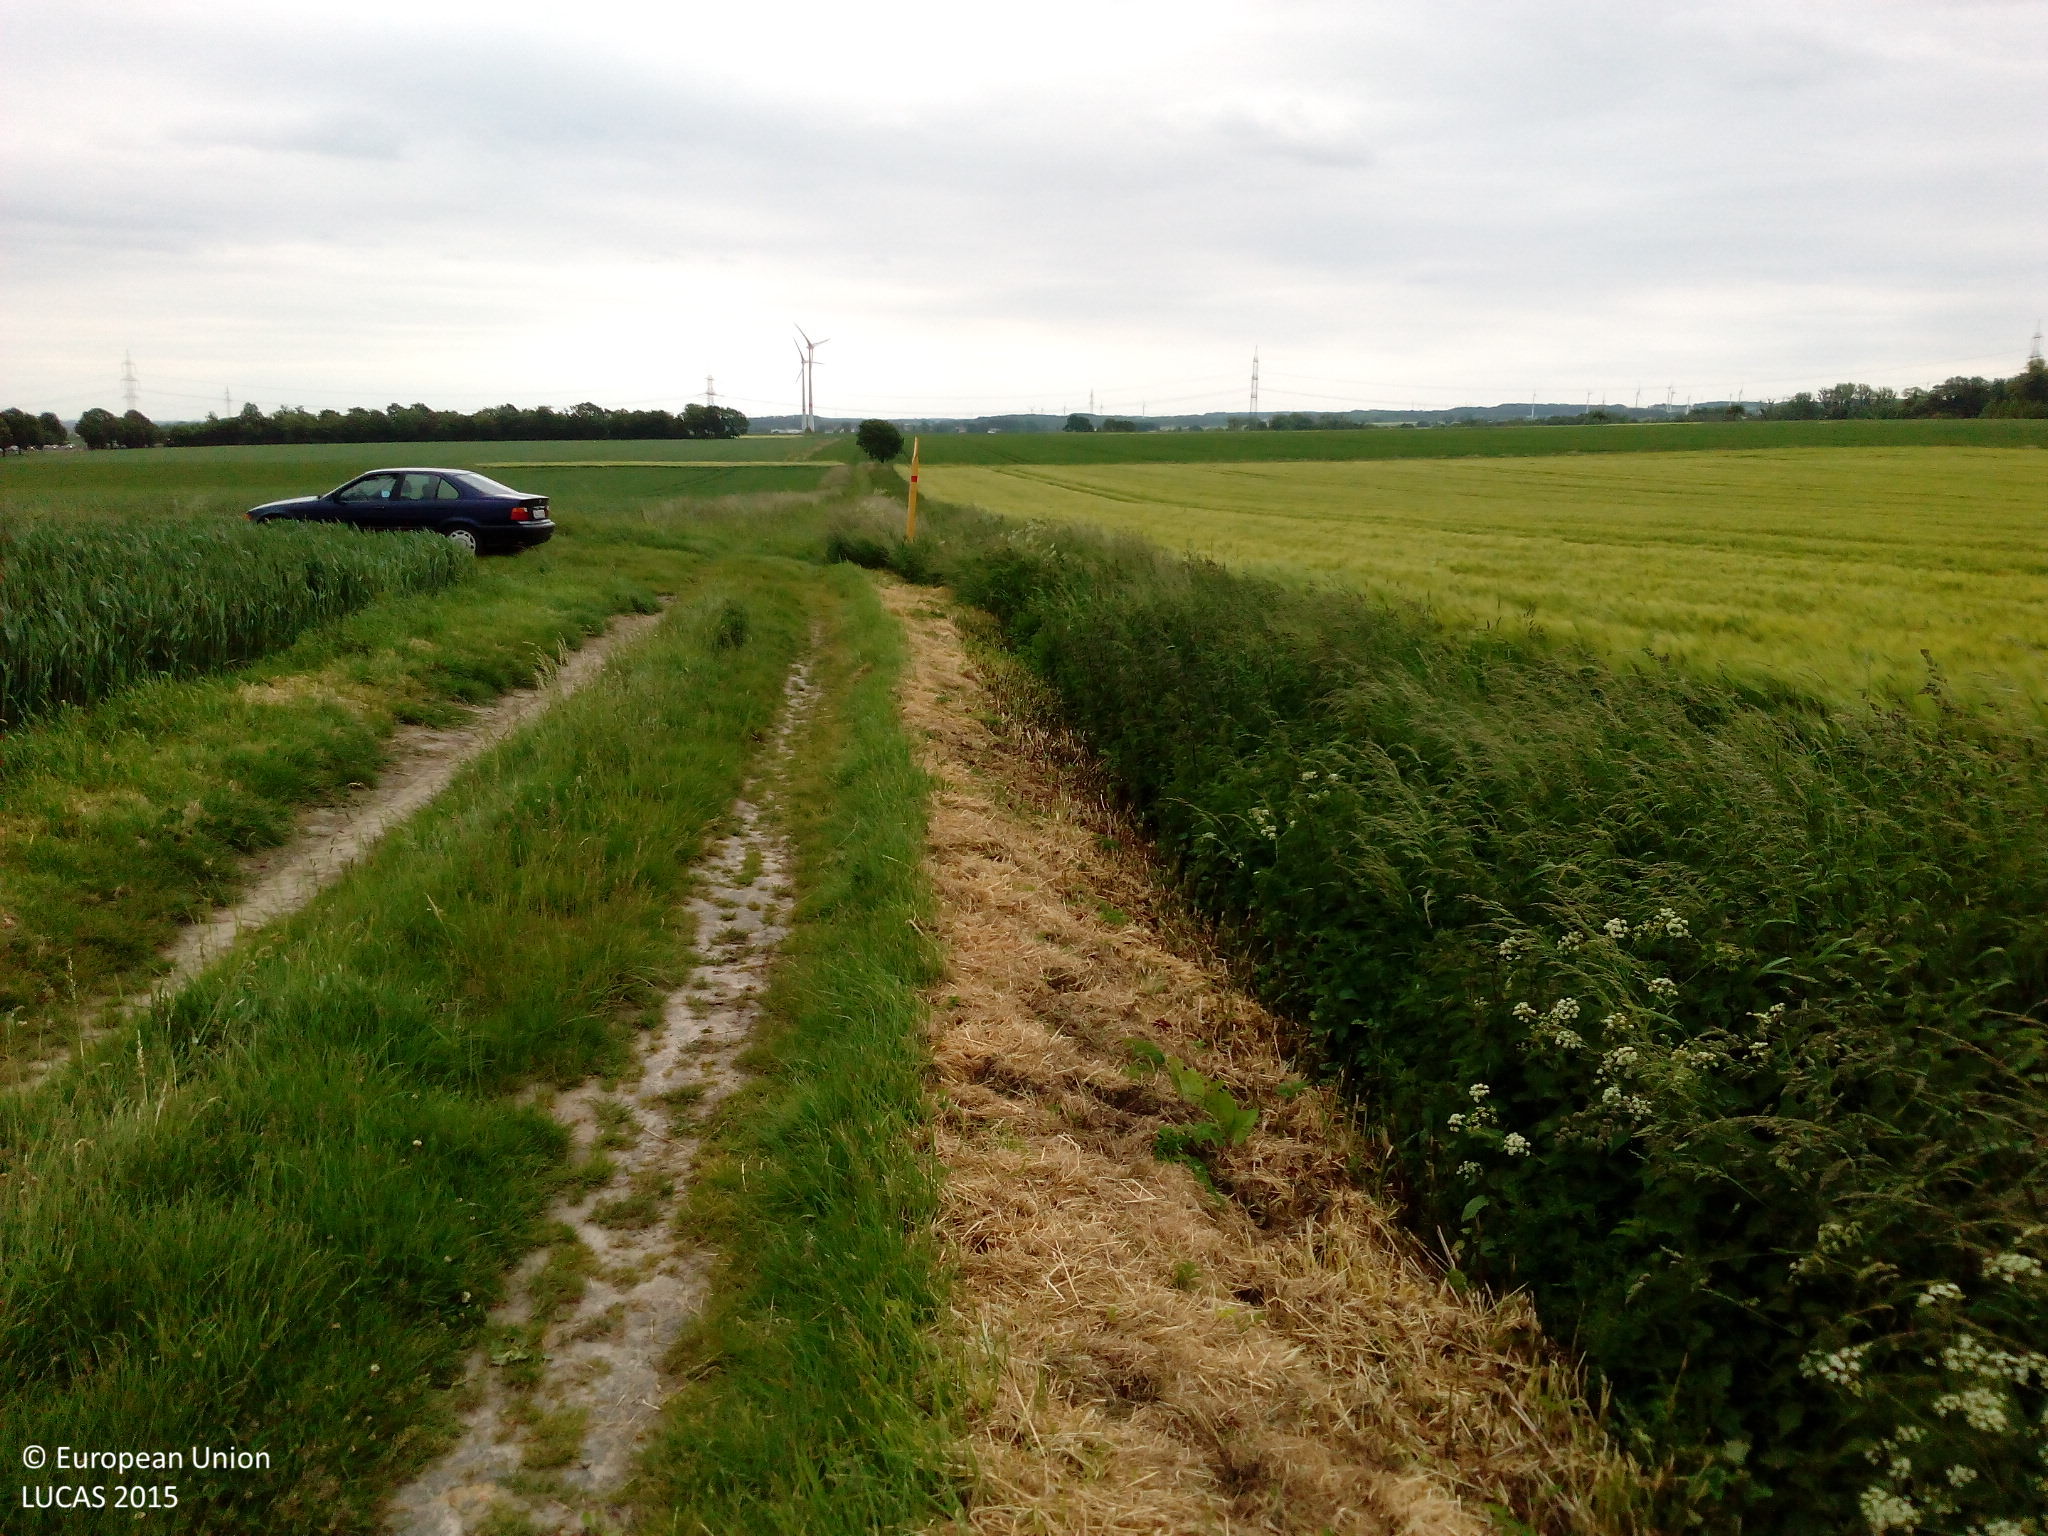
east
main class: Cropland
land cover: Barley
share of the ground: > 75 %
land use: Agriculture (excluding fallow land and kitchen gardens)
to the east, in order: Barley; Grass margins; Tracks; Grass margins; Common wheat
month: June
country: DE
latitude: 51.5330
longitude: 7.9677
